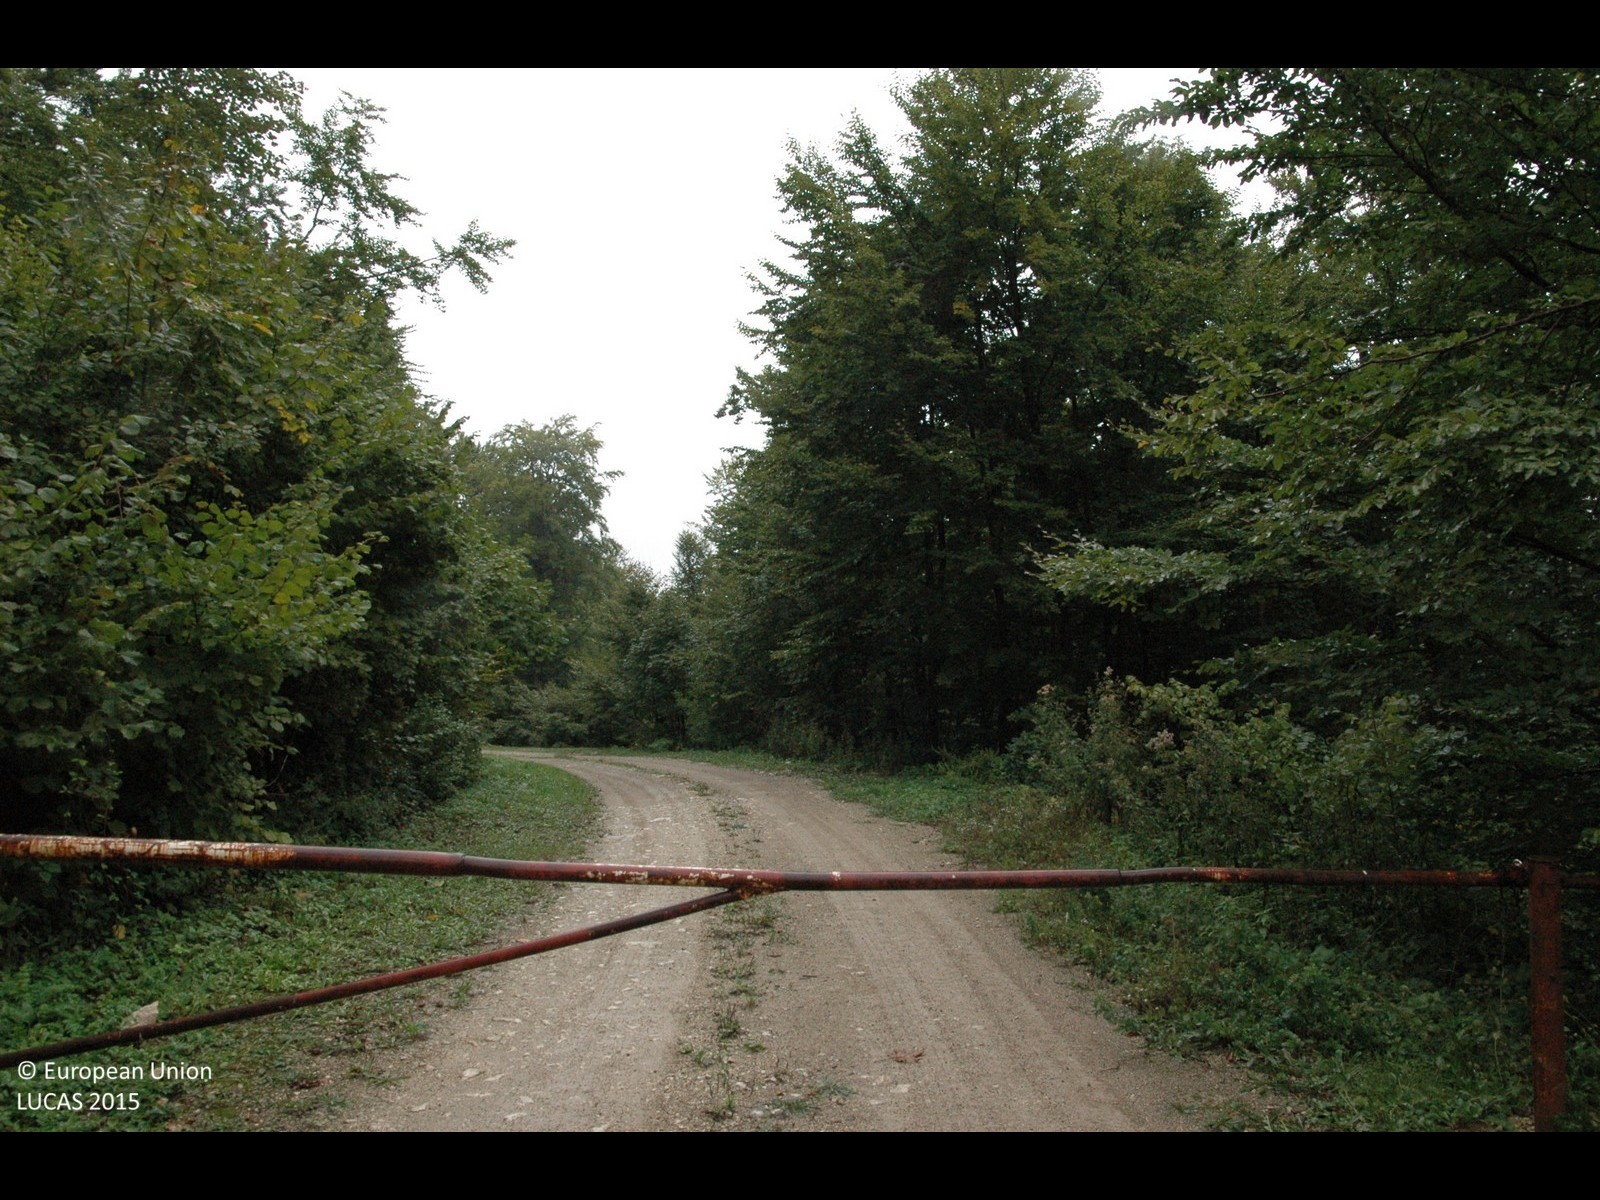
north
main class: Woodland
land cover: Broadleaved woodland
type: beech forest
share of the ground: > 75 %
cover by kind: broadleaved forest trees 100 %
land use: Forestry
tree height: > 5 m
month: September
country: HR
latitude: 44.9951
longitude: 15.5889
